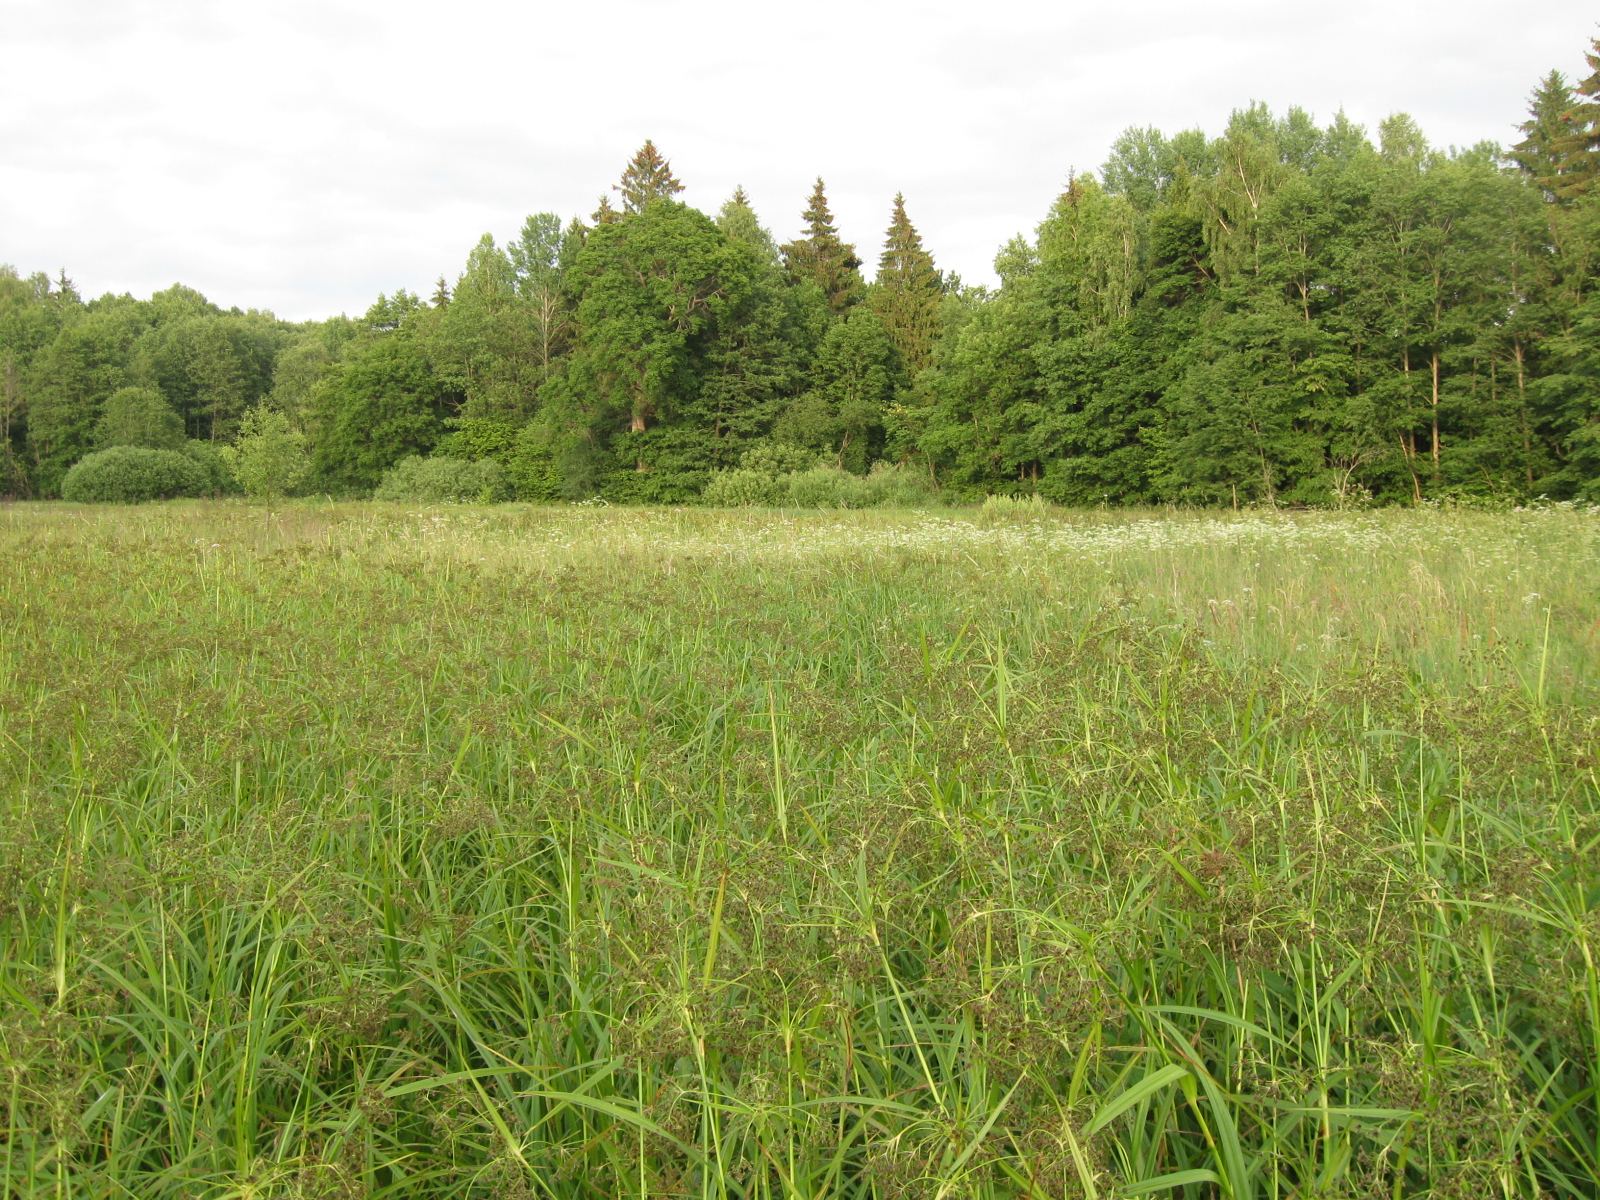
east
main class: Grassland
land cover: Spontaneously vegetated surfaces
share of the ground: > 75 %
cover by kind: herbaceous plants 100 %
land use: Semi-natural and natural areas not in use
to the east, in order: Spontaneously vegetated surfaces; Rivers and streams; Spontaneously vegetated surfaces; Broadleaved woodland; Other mixed woodland; Spruce dominated mixed woodland; Rivers and streams; Other mixed woodland
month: June
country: LT
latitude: 54.5913
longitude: 24.6379
